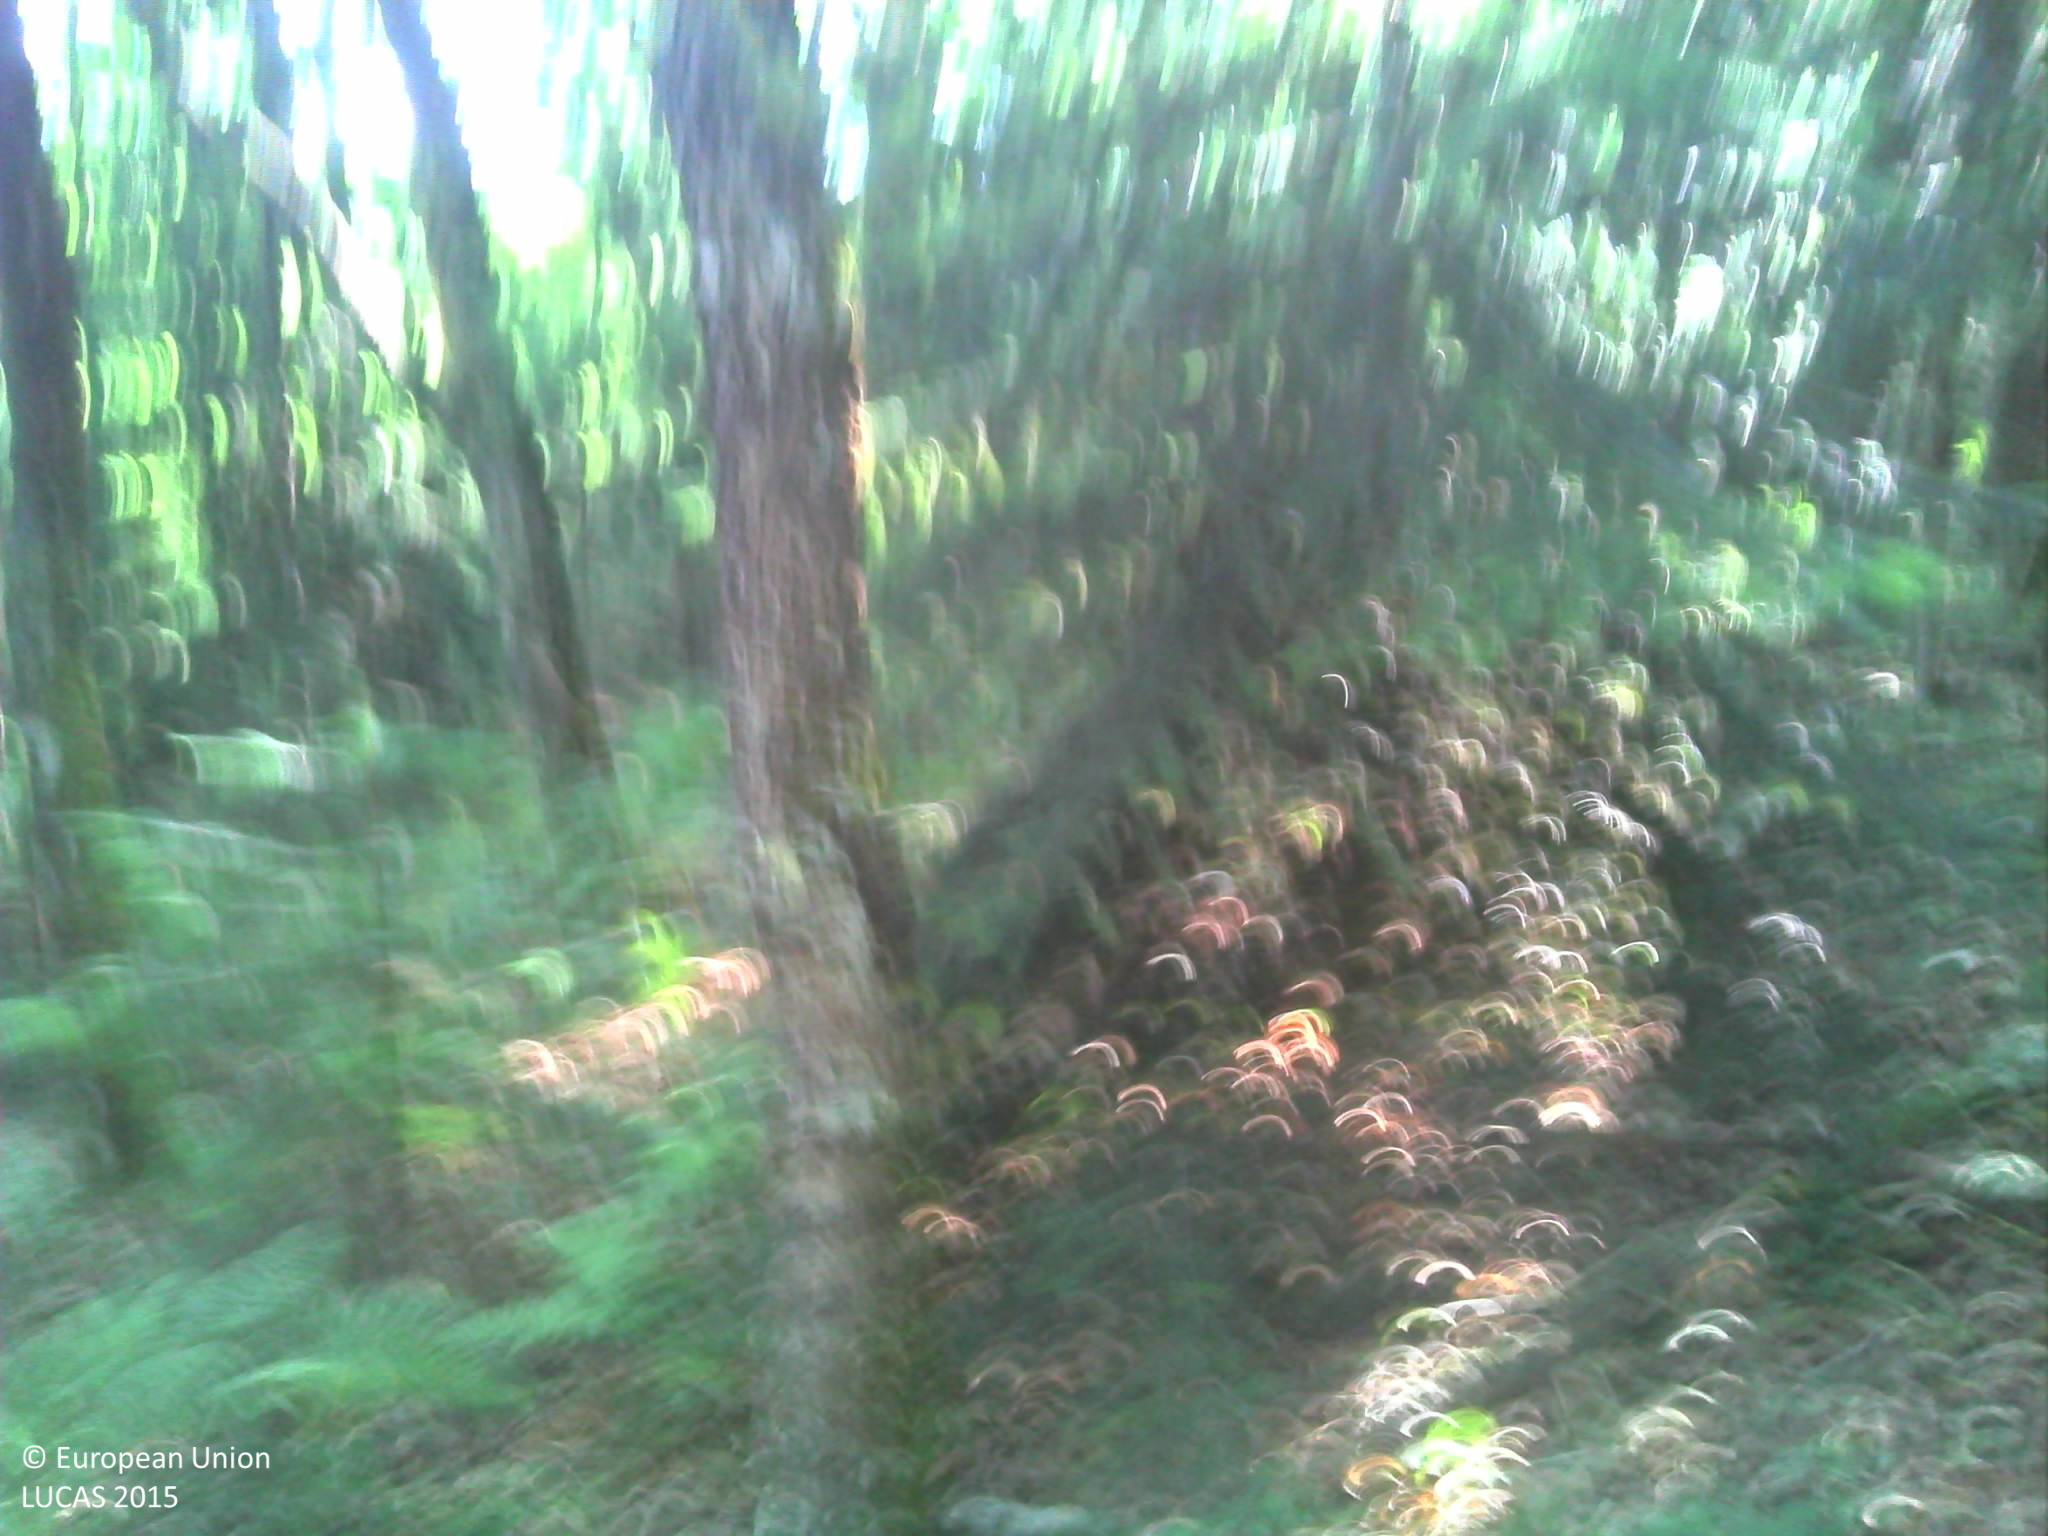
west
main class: Woodland
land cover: Broadleaved woodland
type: thermophilous deciduous forest
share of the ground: > 75 %
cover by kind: broadleaved forest trees 90 %, herbaceous plants 10 %
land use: Forestry
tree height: > 5 m
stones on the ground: < 10 %
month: July
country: FR
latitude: 42.9259
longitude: 2.1063
